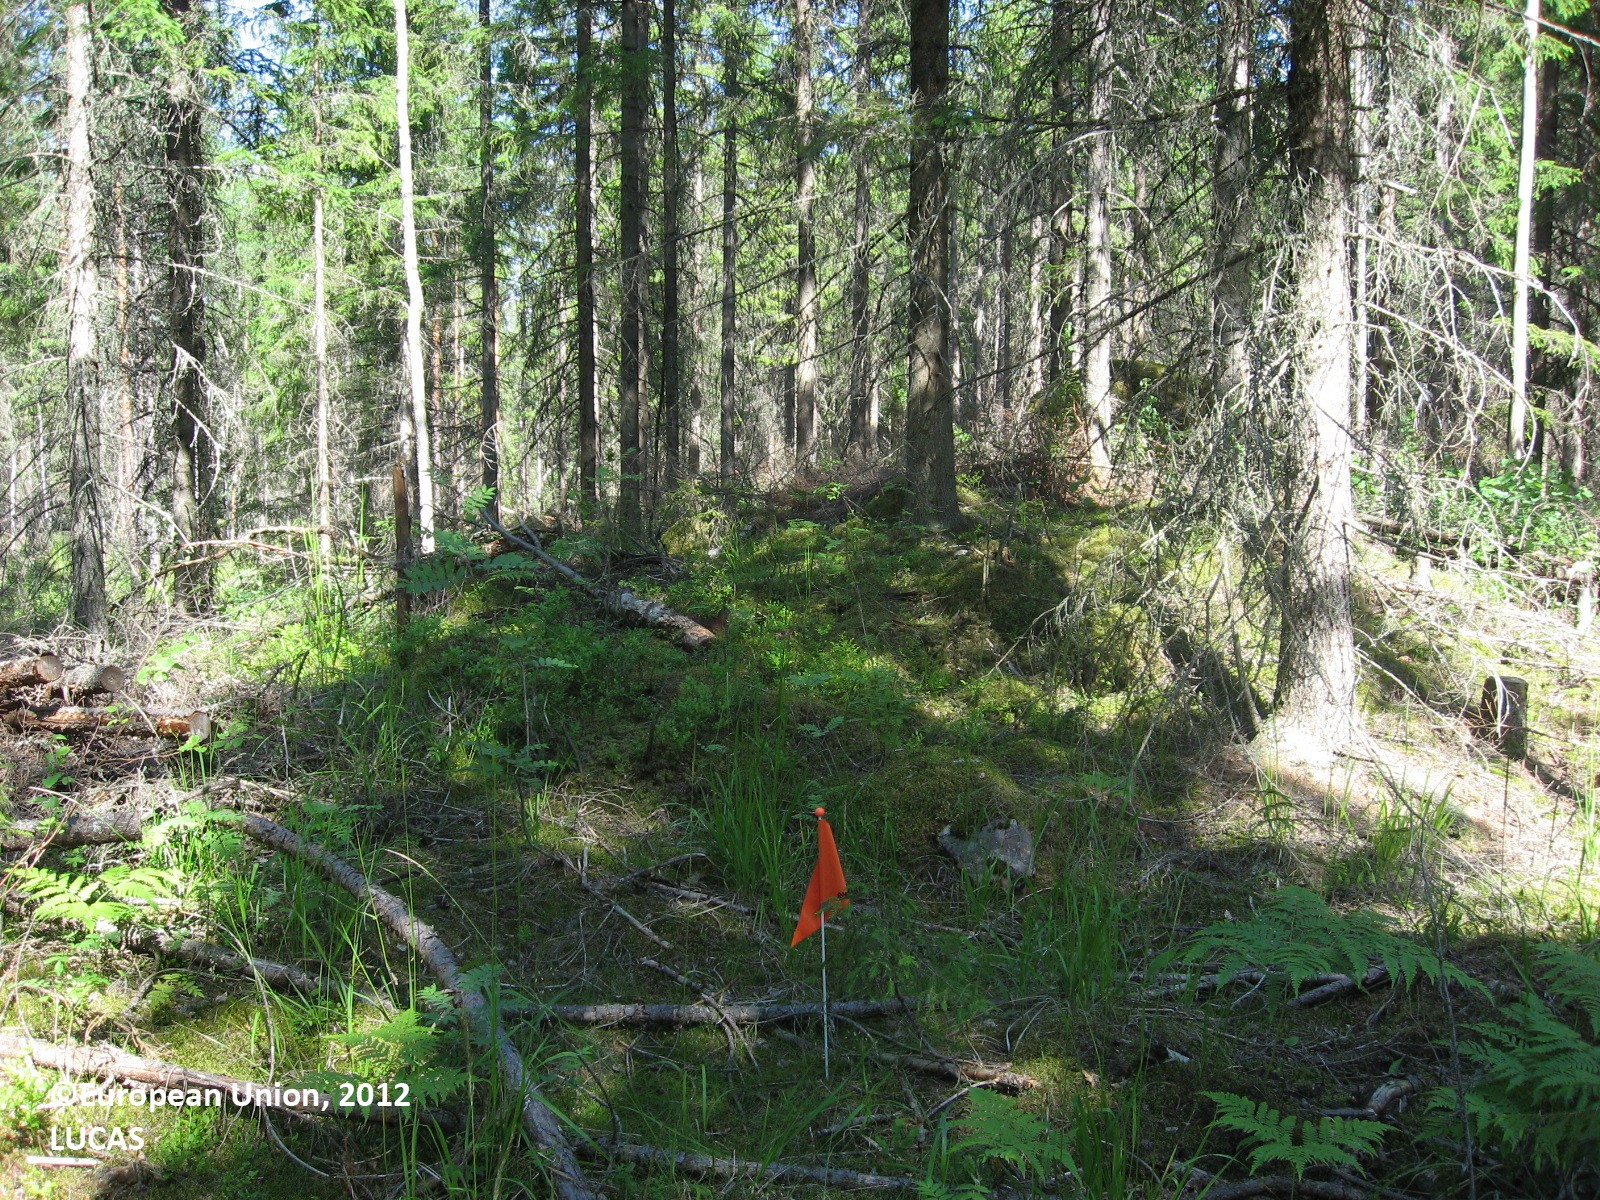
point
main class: Woodland
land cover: Spruce dominated coniferous woodland
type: boreal forest
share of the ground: 50 - 75 %
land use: Forestry
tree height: > 5 m
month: July
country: FI
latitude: 61.0878
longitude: 26.4481
